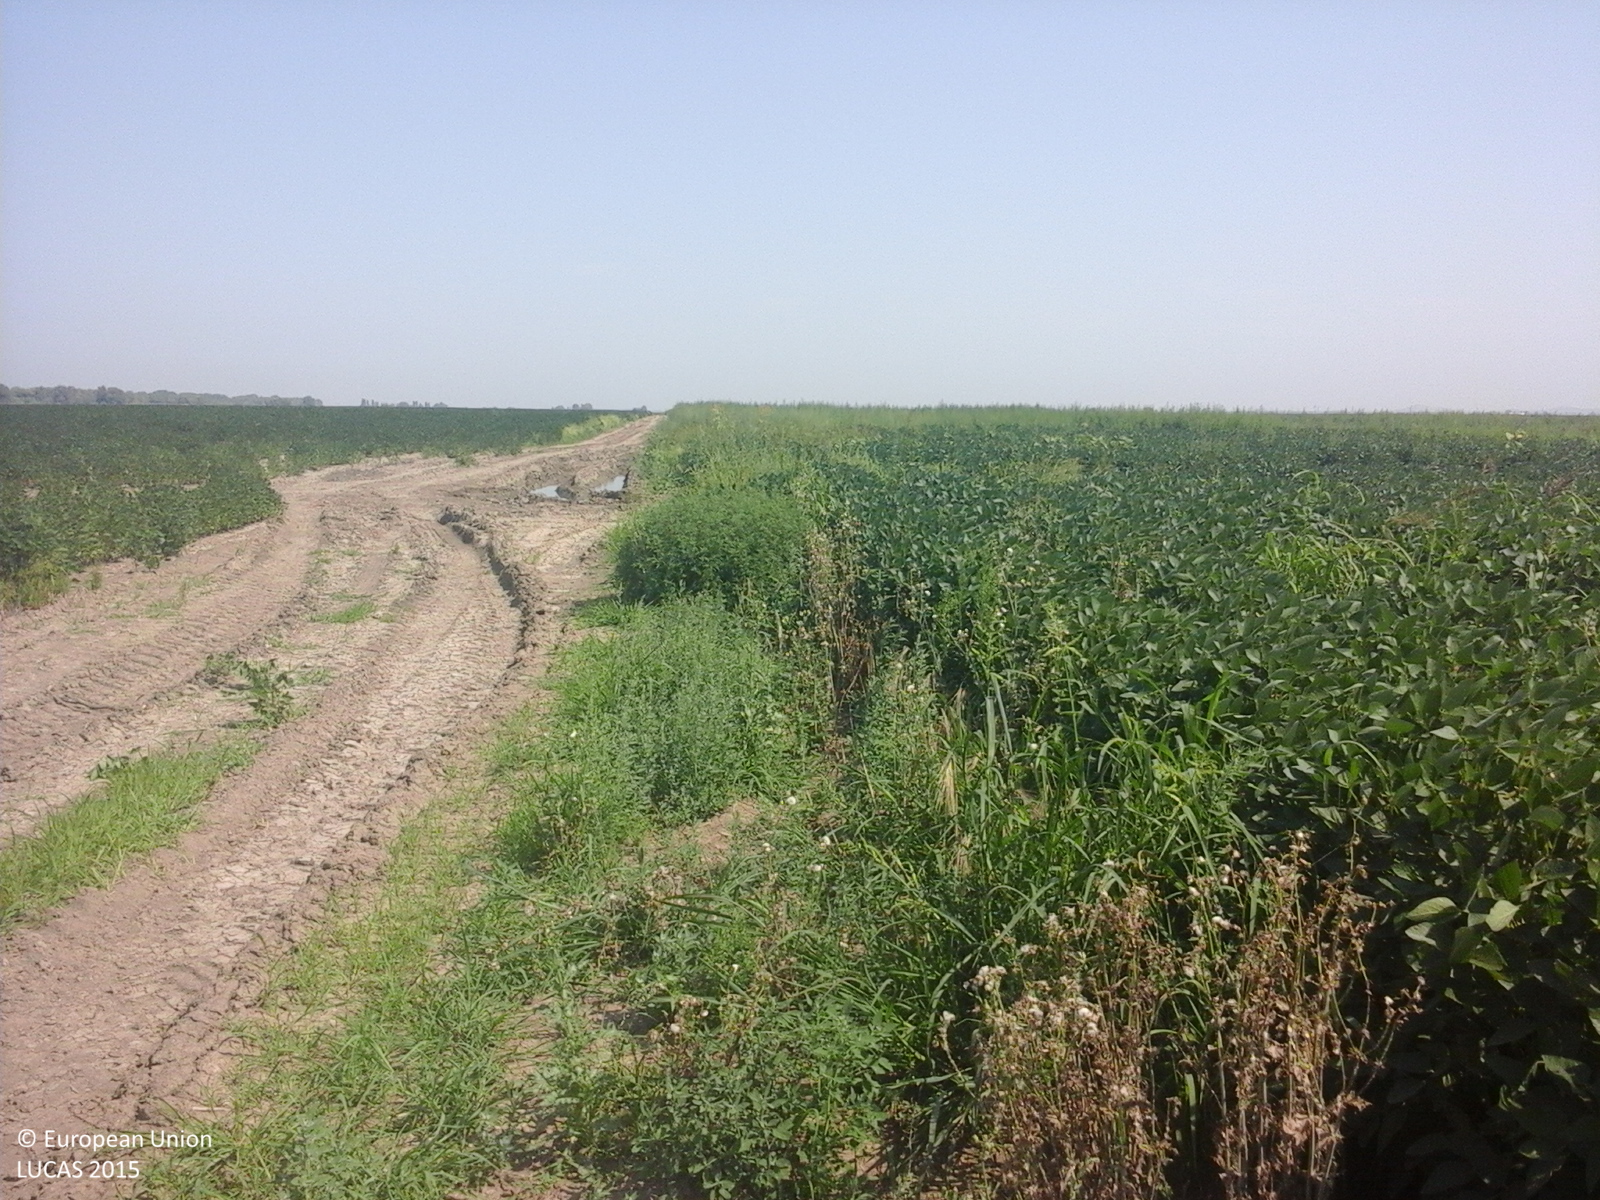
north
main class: Cropland
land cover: Soya
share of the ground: > 75 %
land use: Agriculture (excluding fallow land and kitchen gardens)
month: August
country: RO
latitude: 45.1559
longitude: 28.0124
